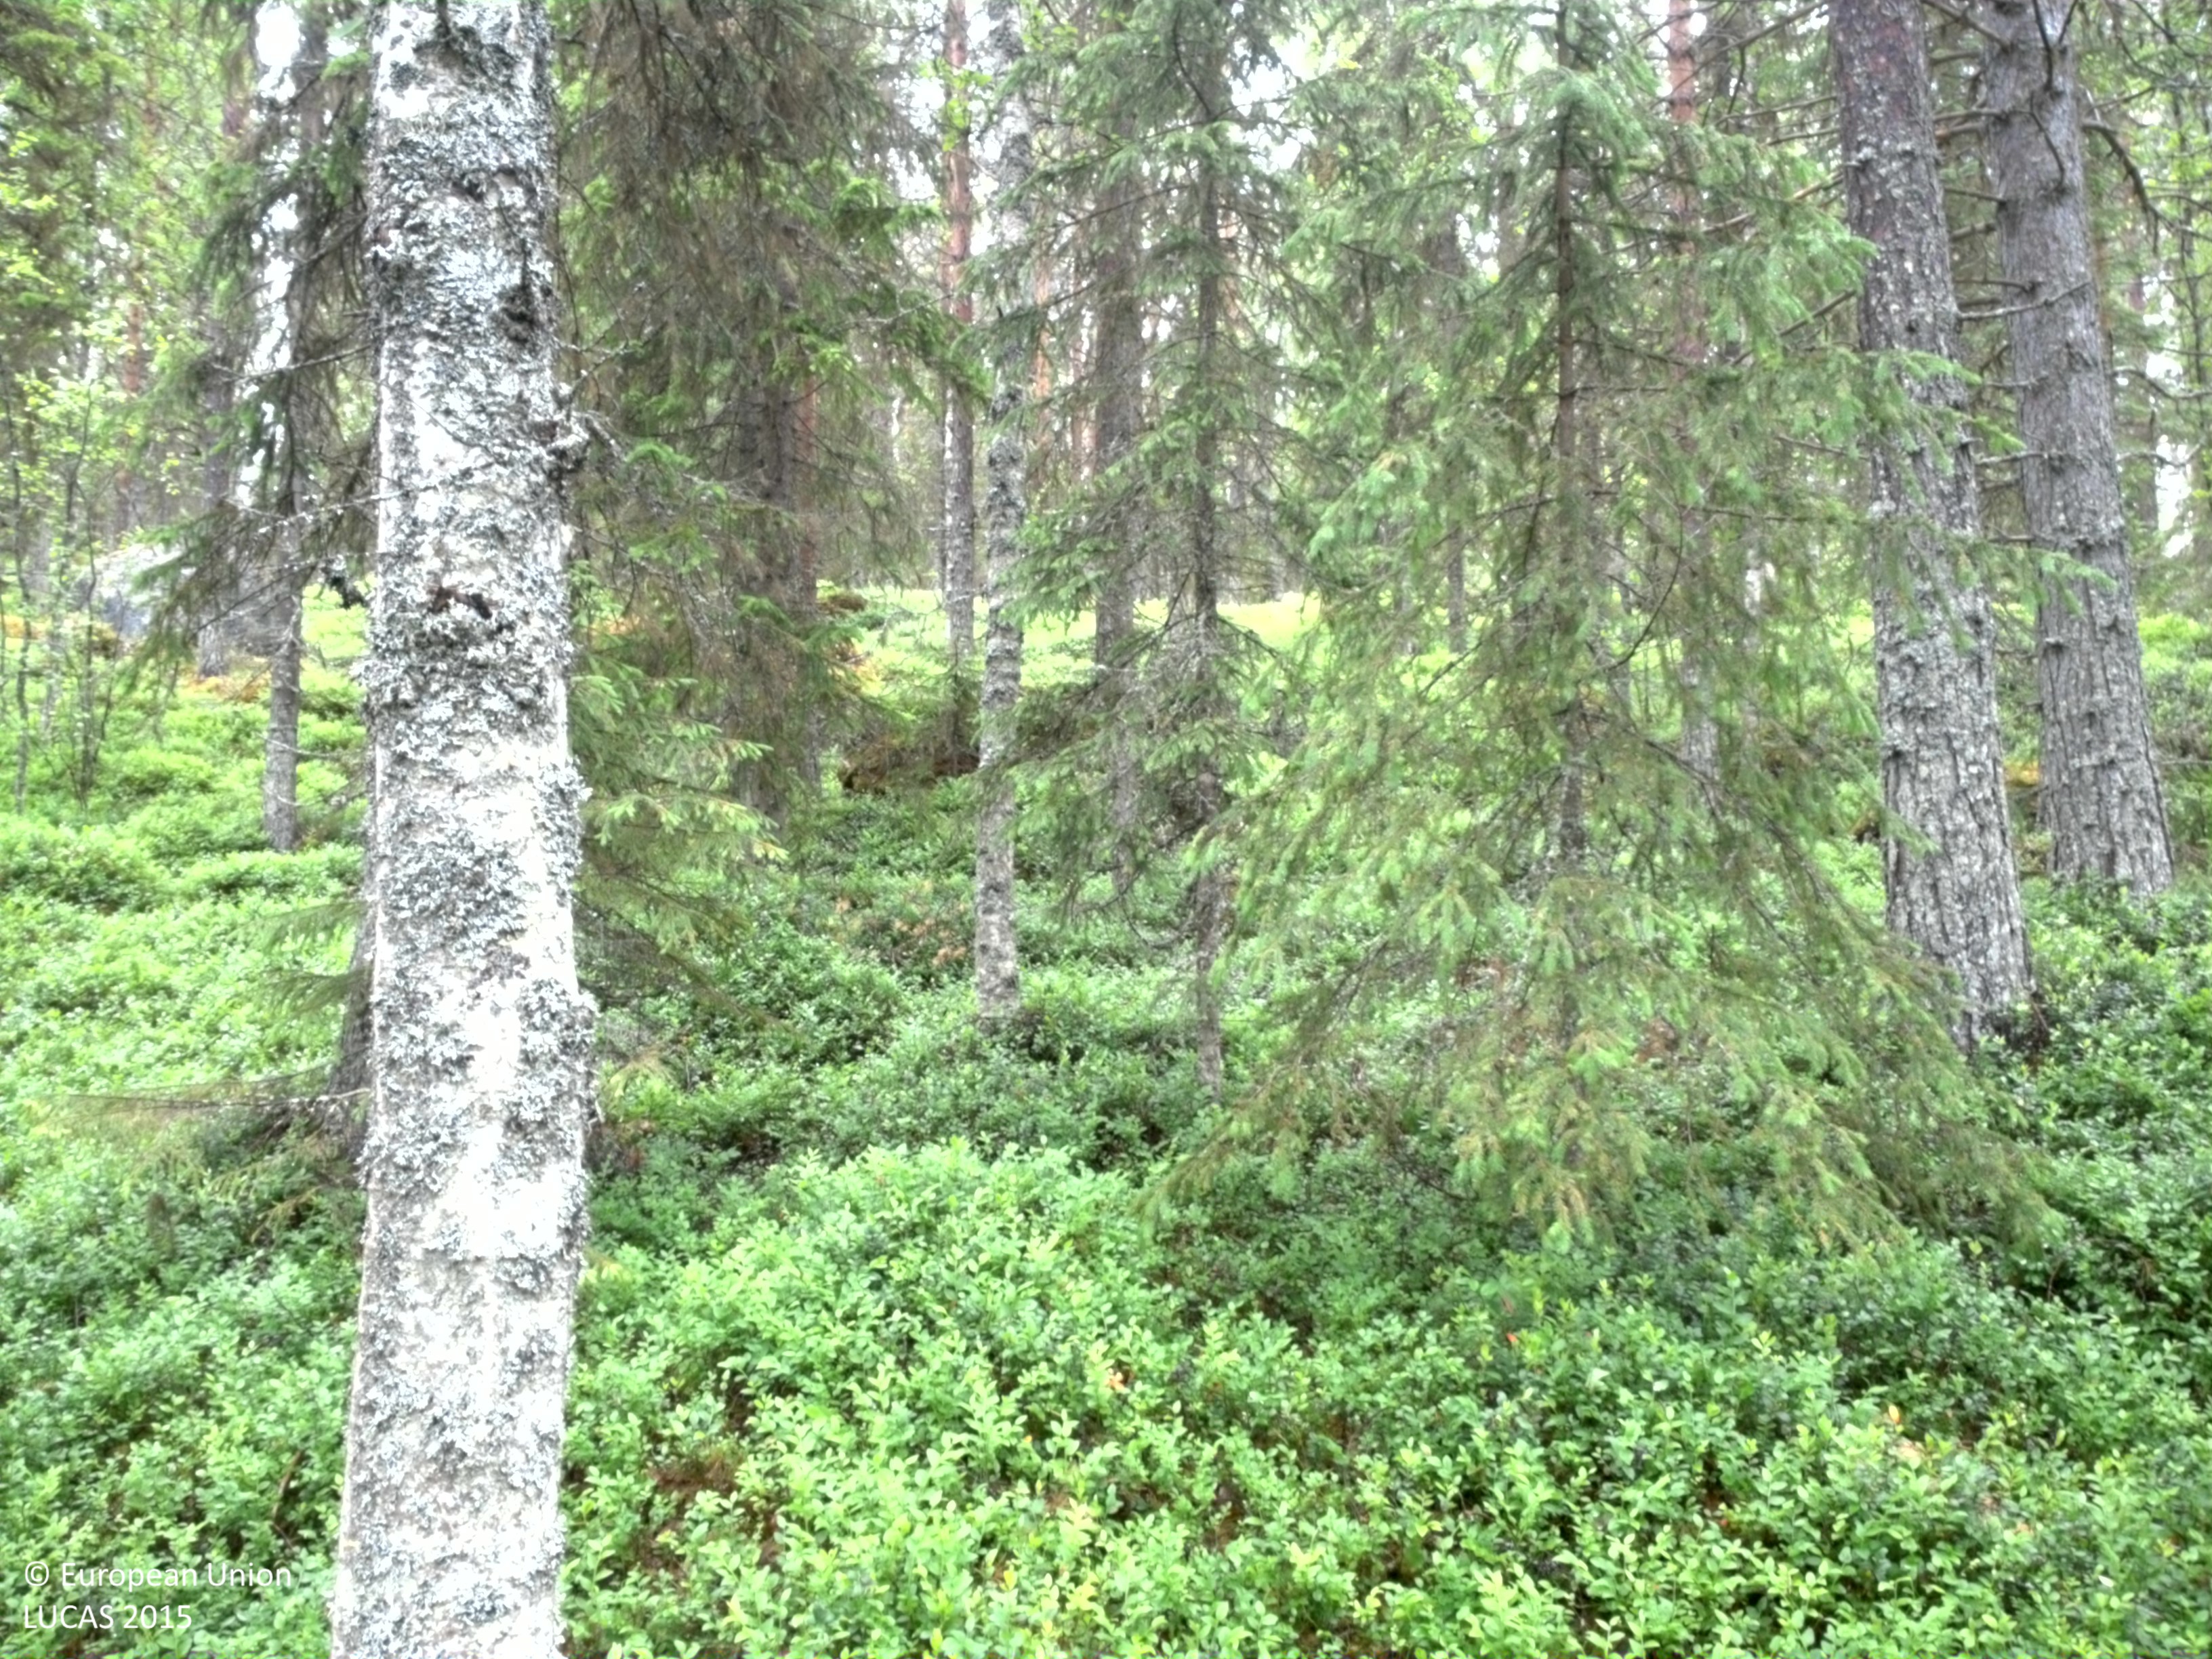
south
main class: Woodland
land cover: Pine dominated coniferous woodland
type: hemiboreal forest and nemoral coniferous forest and mixed broadleaved-coniferous forest
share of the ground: 50 - 75 %
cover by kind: coniferous forest trees 65 %, shrubs 20 %, broadleaved forest trees 10 %, lichens and mosses 5 %
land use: Forestry
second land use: Amenities, museums, leisure
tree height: > 5 m
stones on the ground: 10 - 25 %
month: July
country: SE
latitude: 64.6207
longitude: 18.2267
